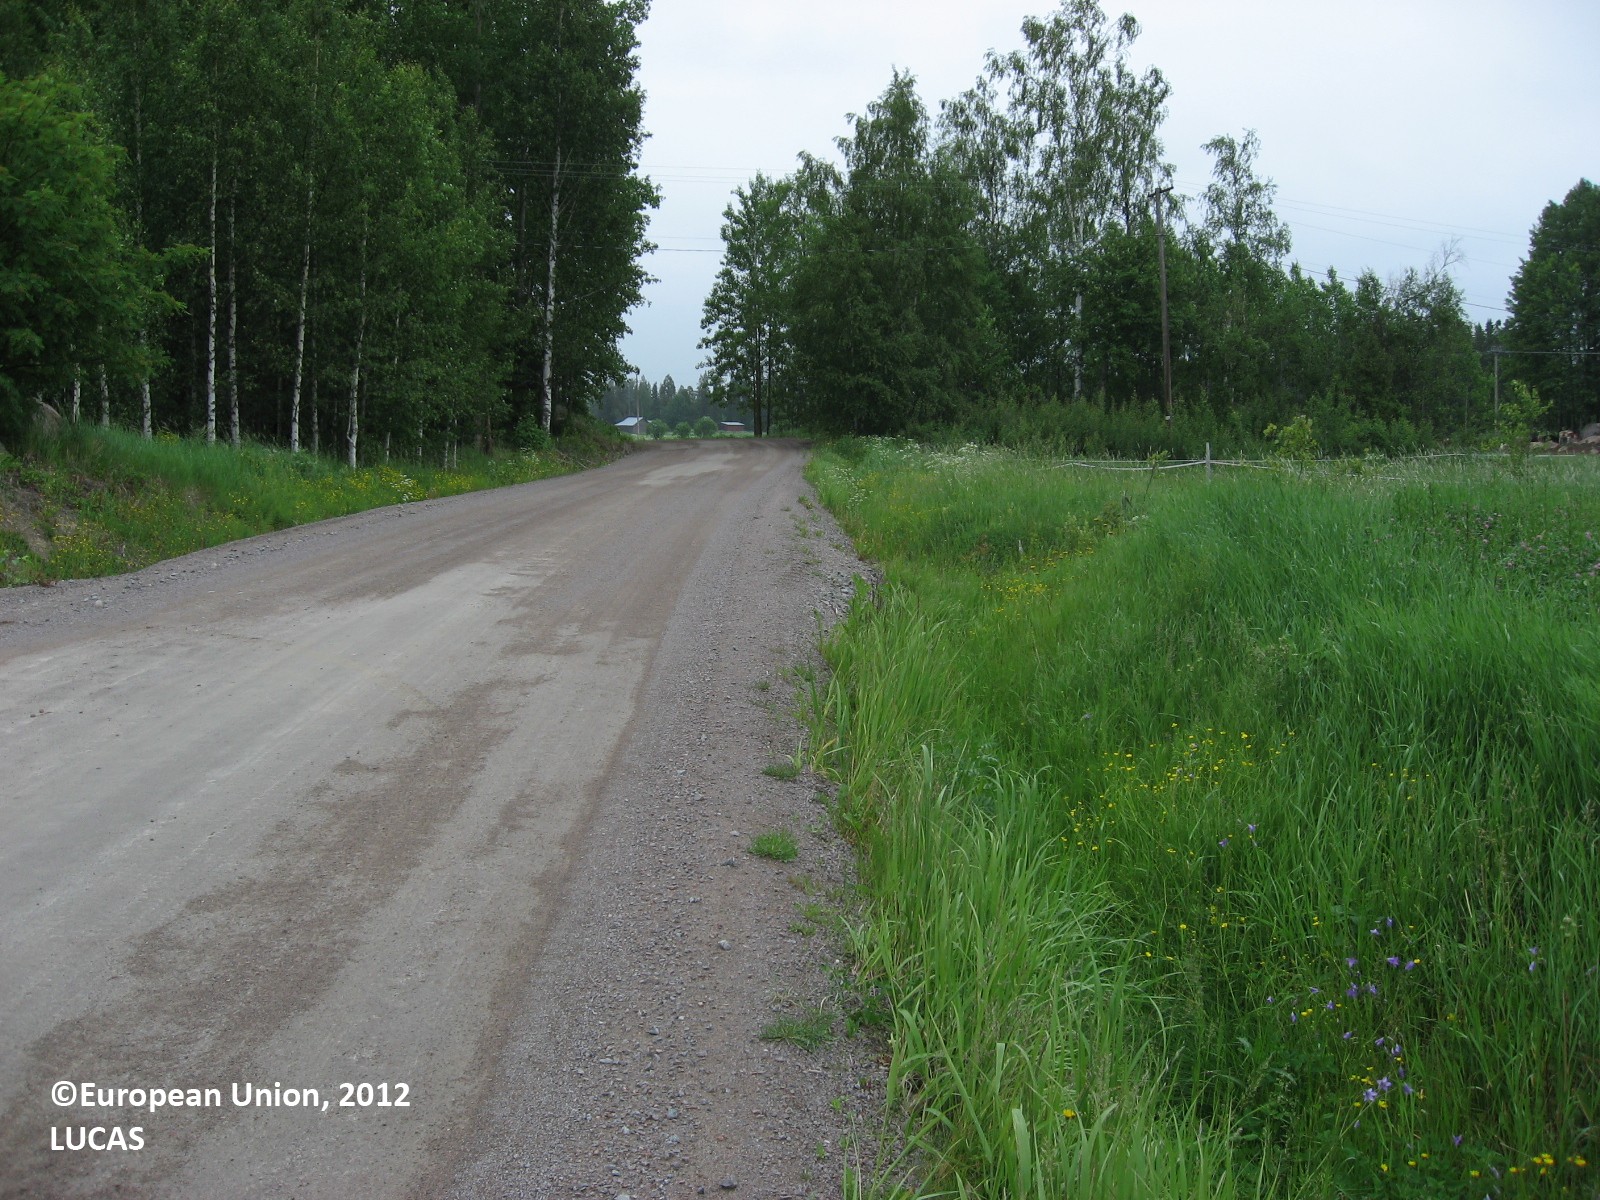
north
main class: Cropland
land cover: Clovers
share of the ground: > 75 %
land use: Agriculture (excluding fallow land and kitchen gardens)
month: June
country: FI
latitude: 60.5174
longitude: 26.2699
